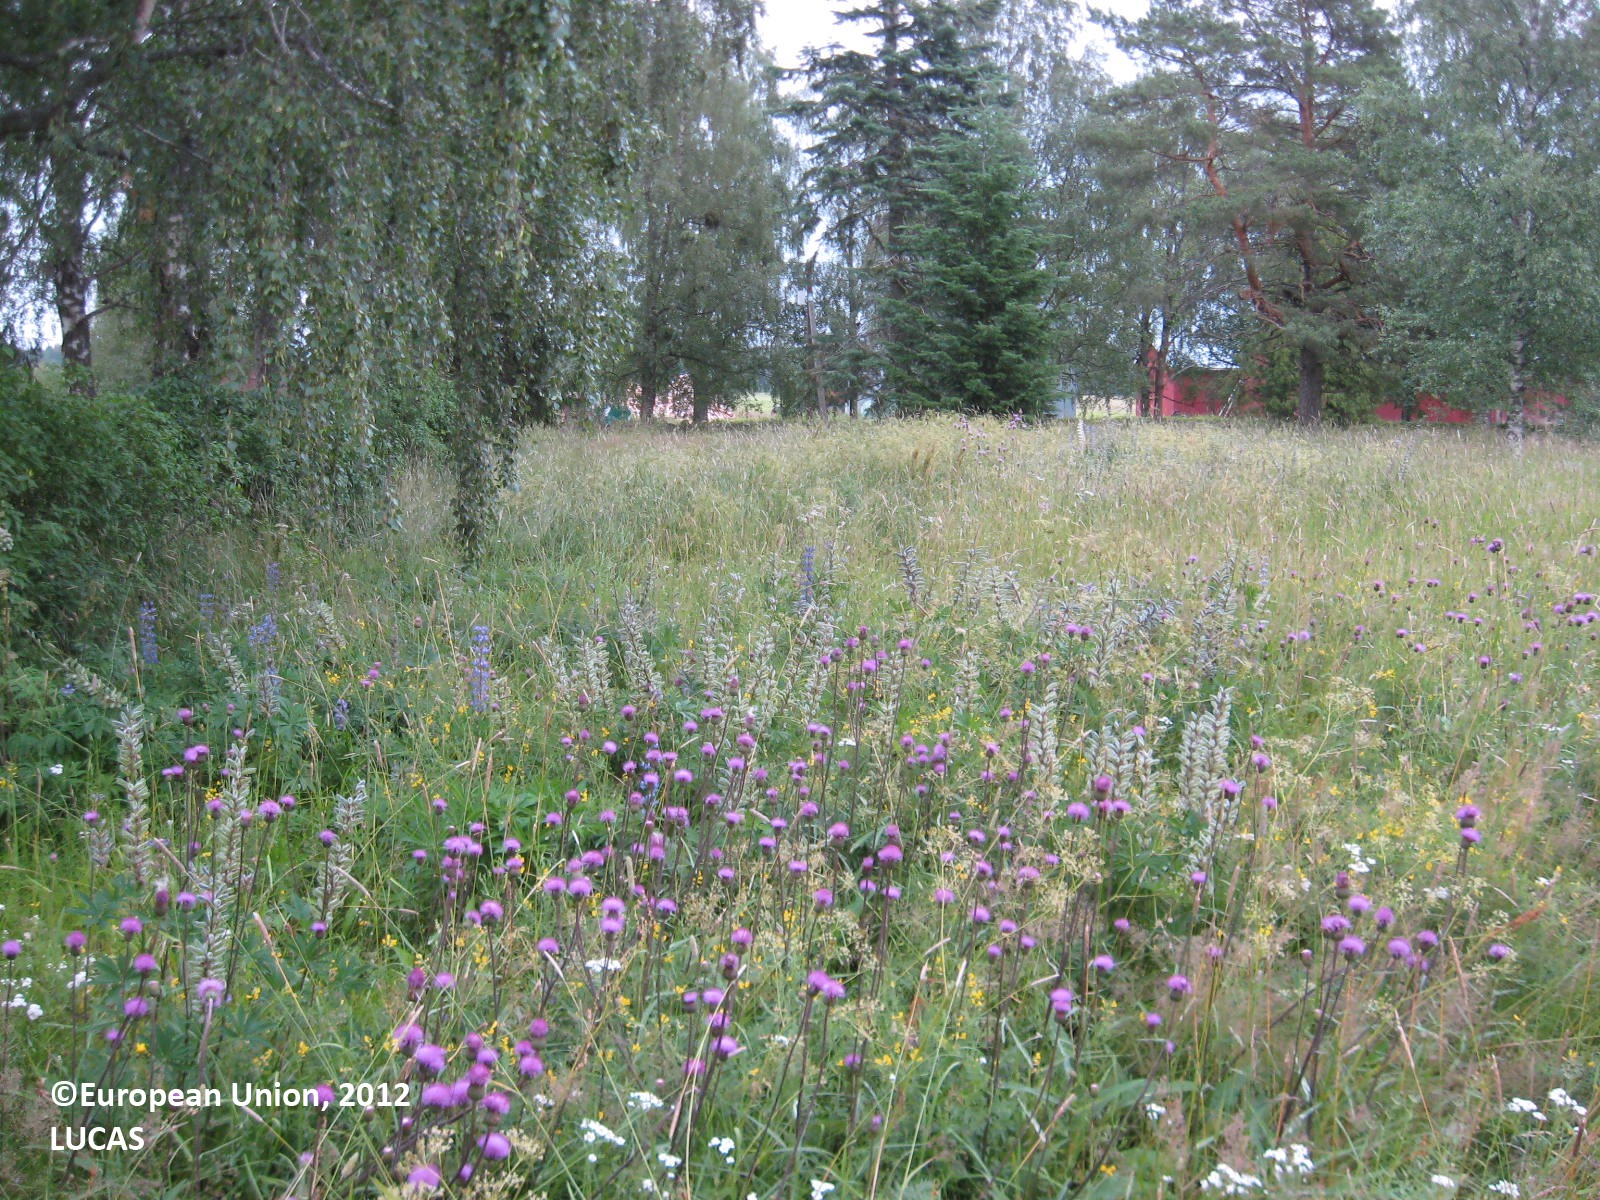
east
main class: Grassland
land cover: Grassland without tree/shrub cover
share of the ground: > 75 %
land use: Residential
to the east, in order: Grassland without tree/shrub cover; Electric lines; Grassland without tree/shrub cover; Lines of trees; Ditches and canals; Electric lines; Ditches and canals; Grass margins; Paved roads, cycling and walking lanes; Grass margins; Ditches and canals; Grassland without tree/shrub cover; Single bushes/trees; Grassland without tree/shrub cover; Artificial constructions; Grass margins; Barley
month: July
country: FI
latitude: 62.5391
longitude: 21.4526
